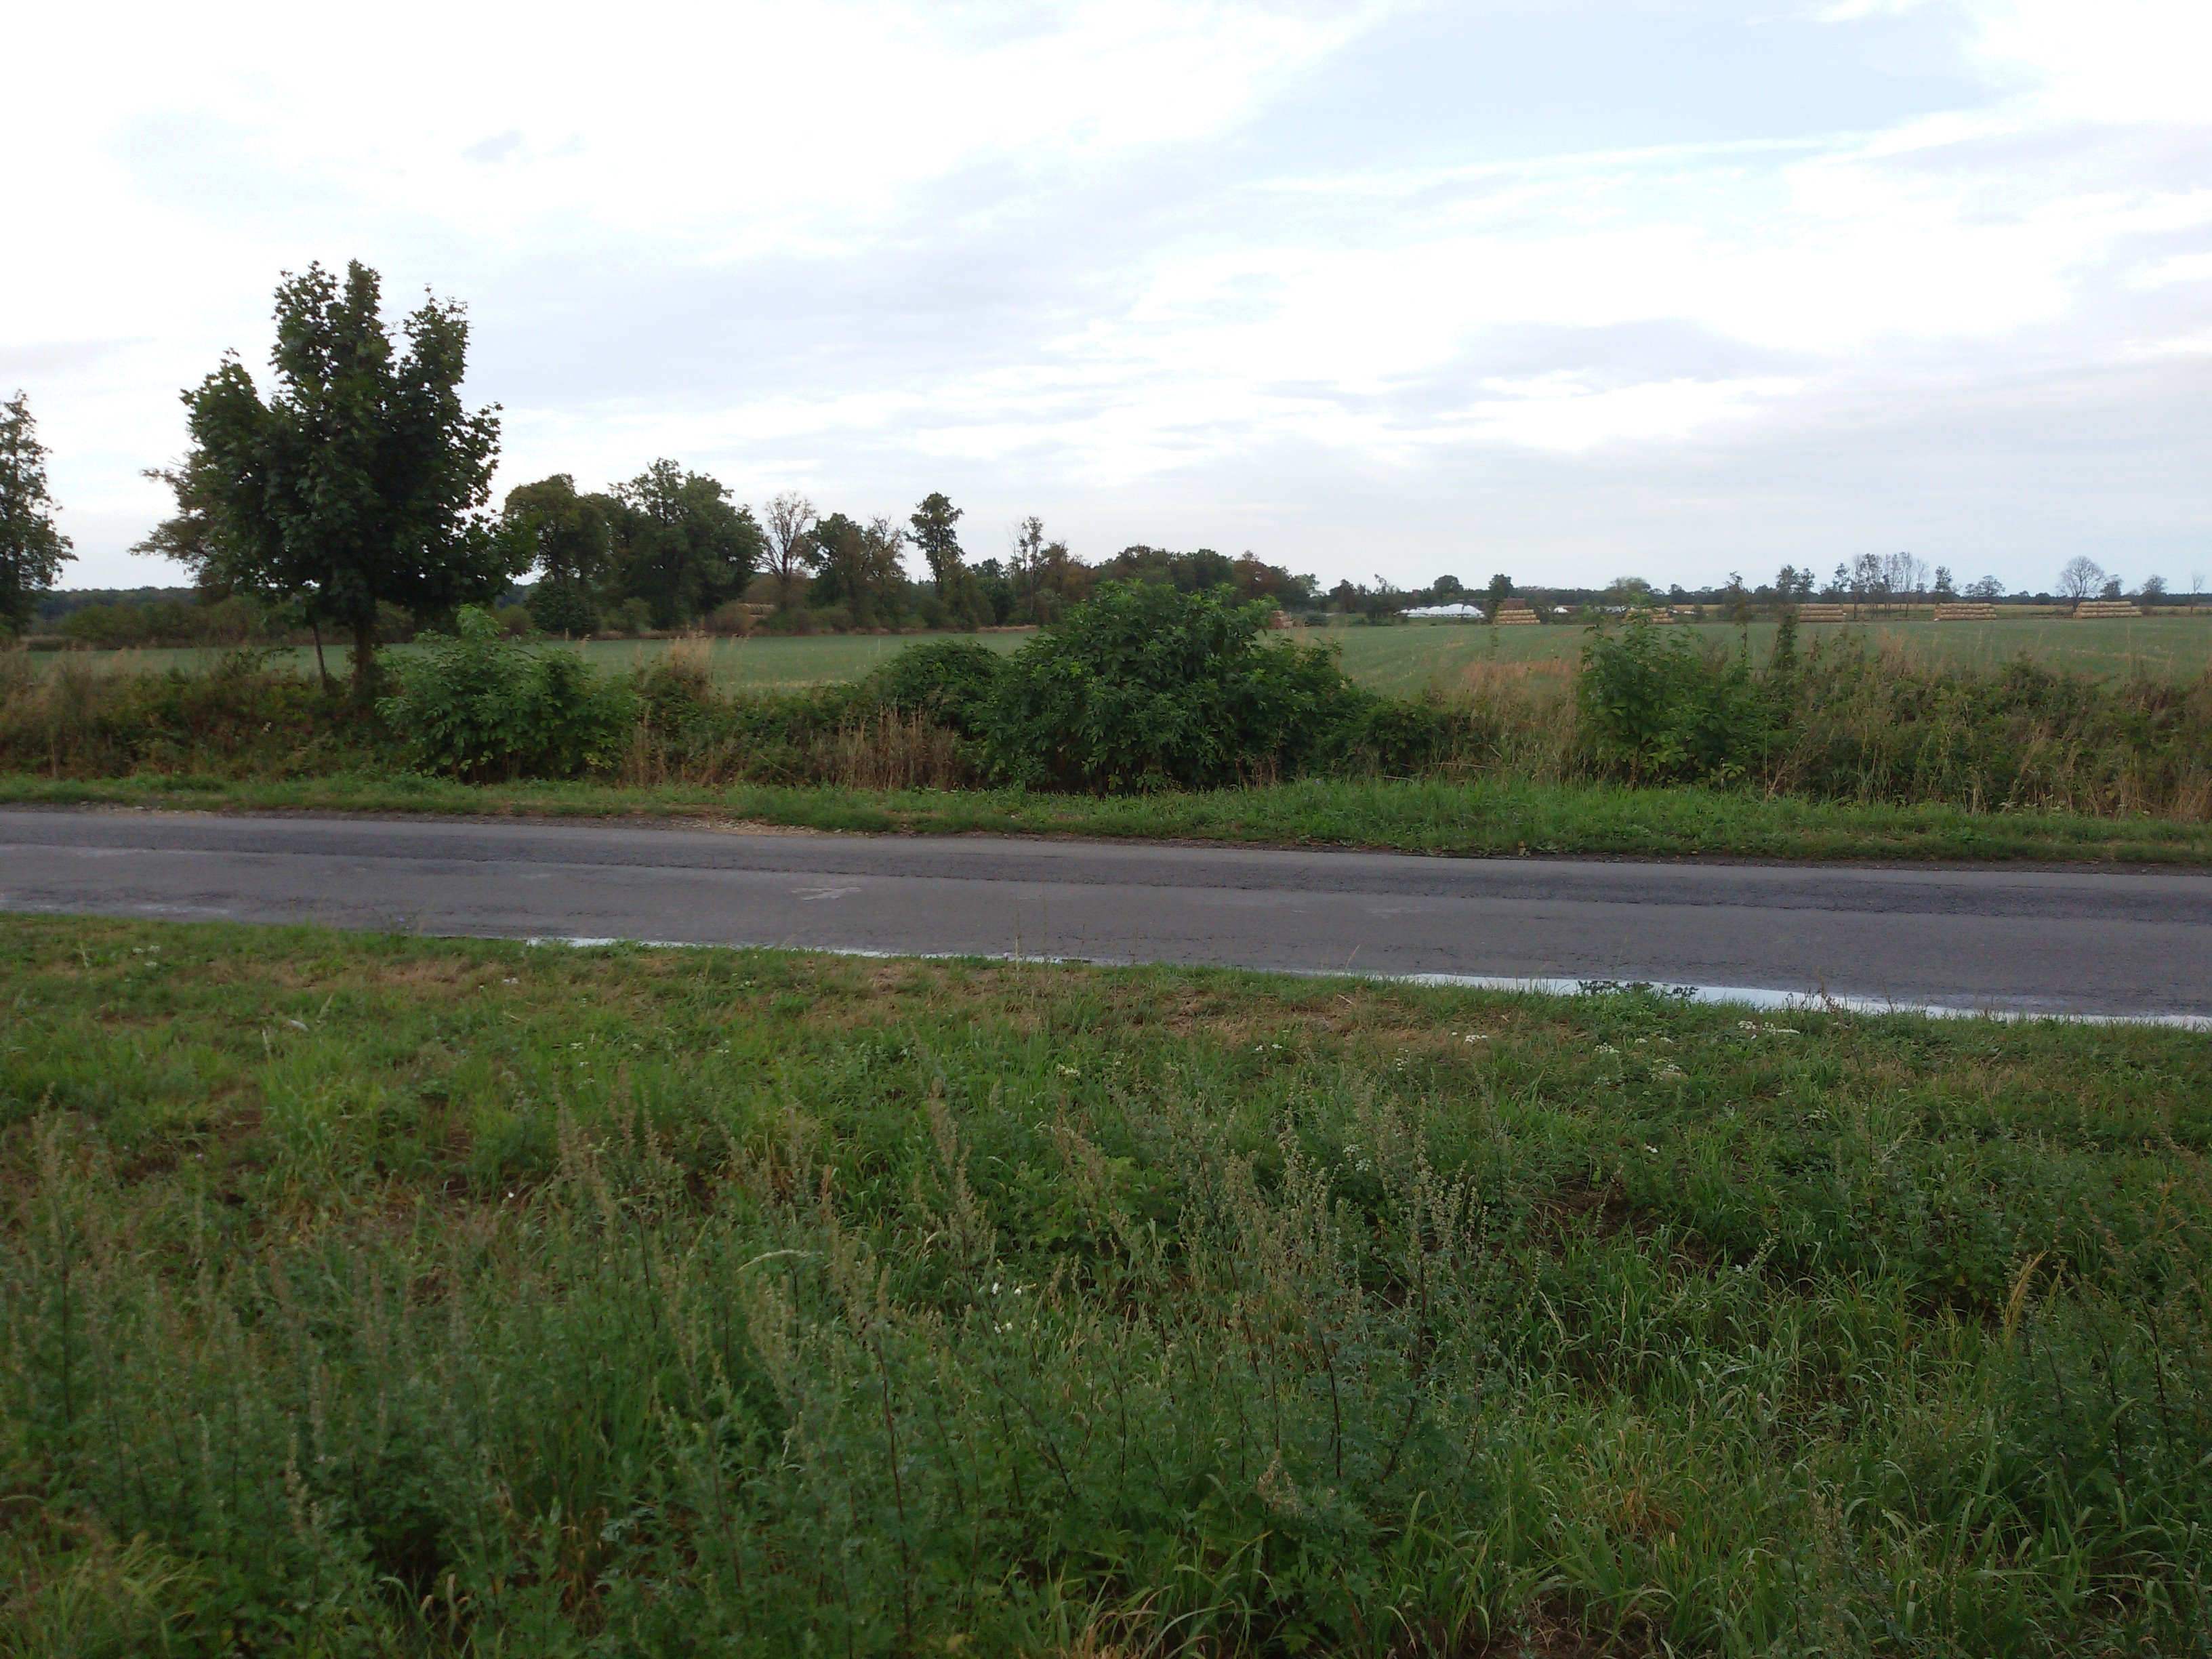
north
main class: Cropland
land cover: Maize
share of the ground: > 75 %
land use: Agriculture (excluding fallow land and kitchen gardens)
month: August
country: PL
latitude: 51.8789
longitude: 17.9031
